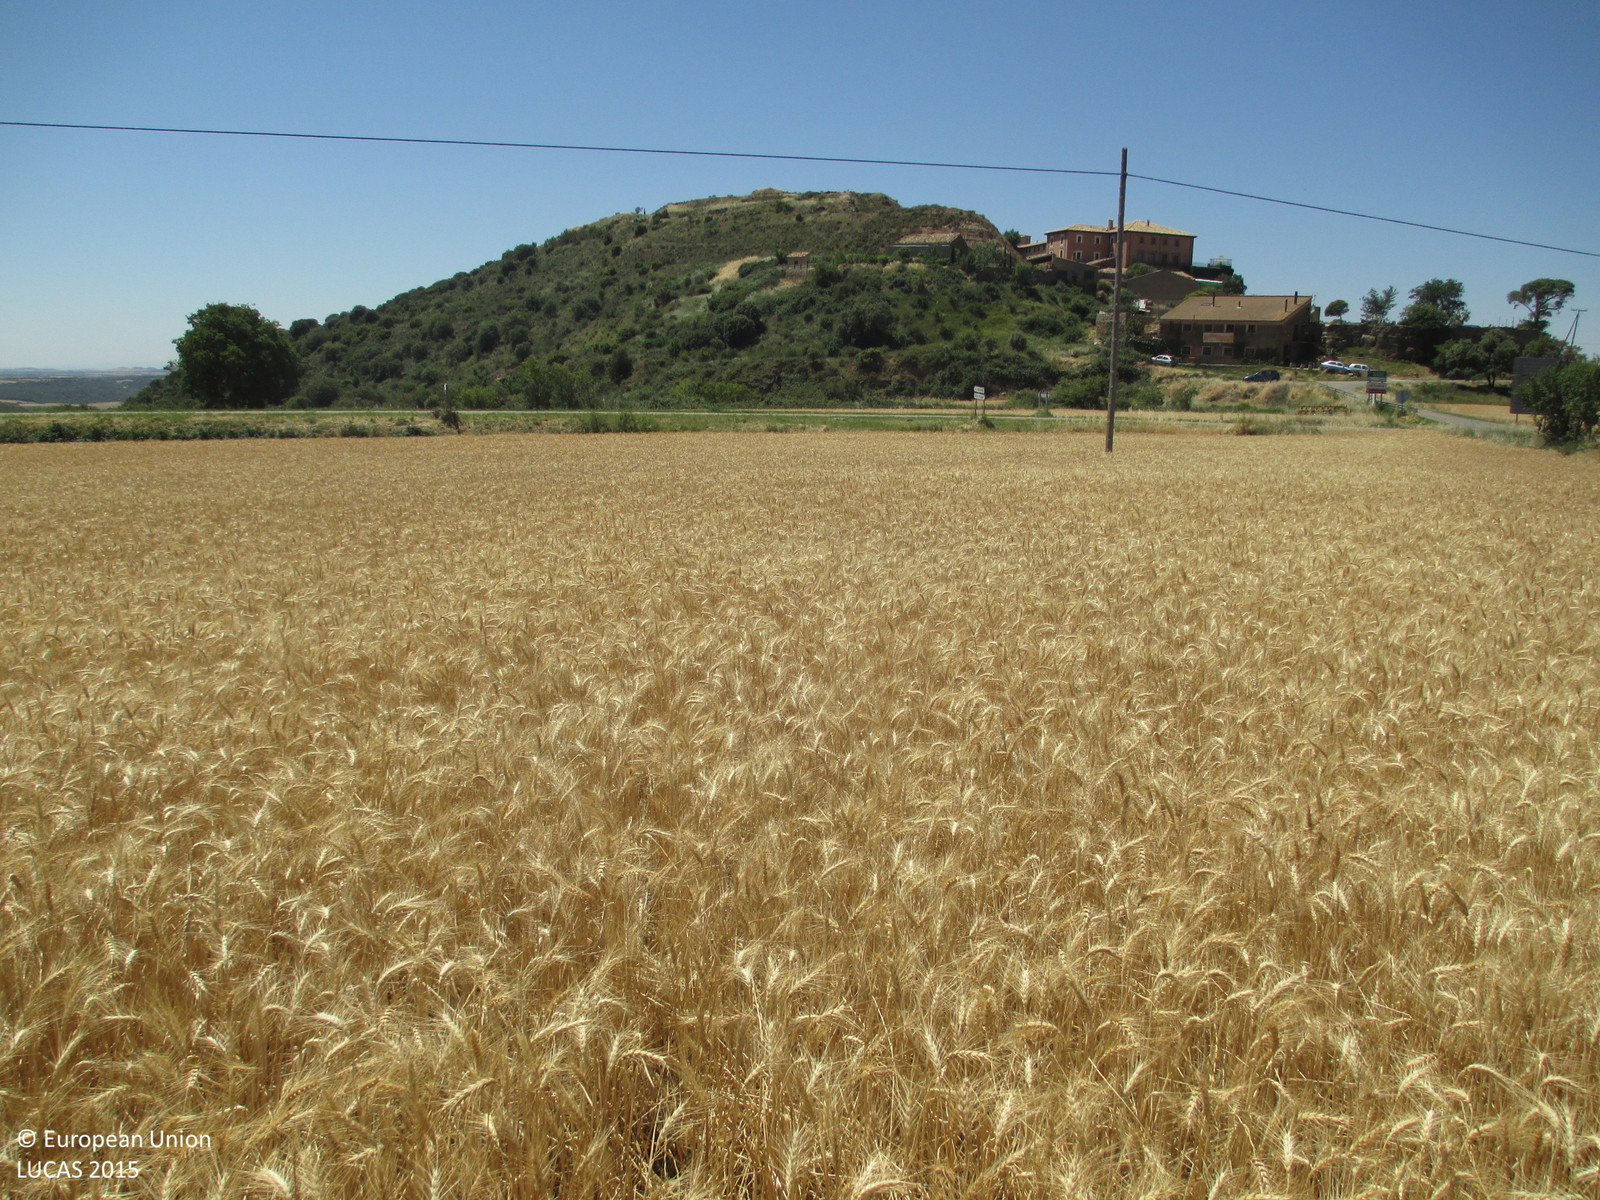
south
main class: Cropland
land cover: Durum wheat
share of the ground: > 75 %
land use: Agriculture (excluding fallow land and kitchen gardens)
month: June
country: ES
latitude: 42.1999
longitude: -0.3044
